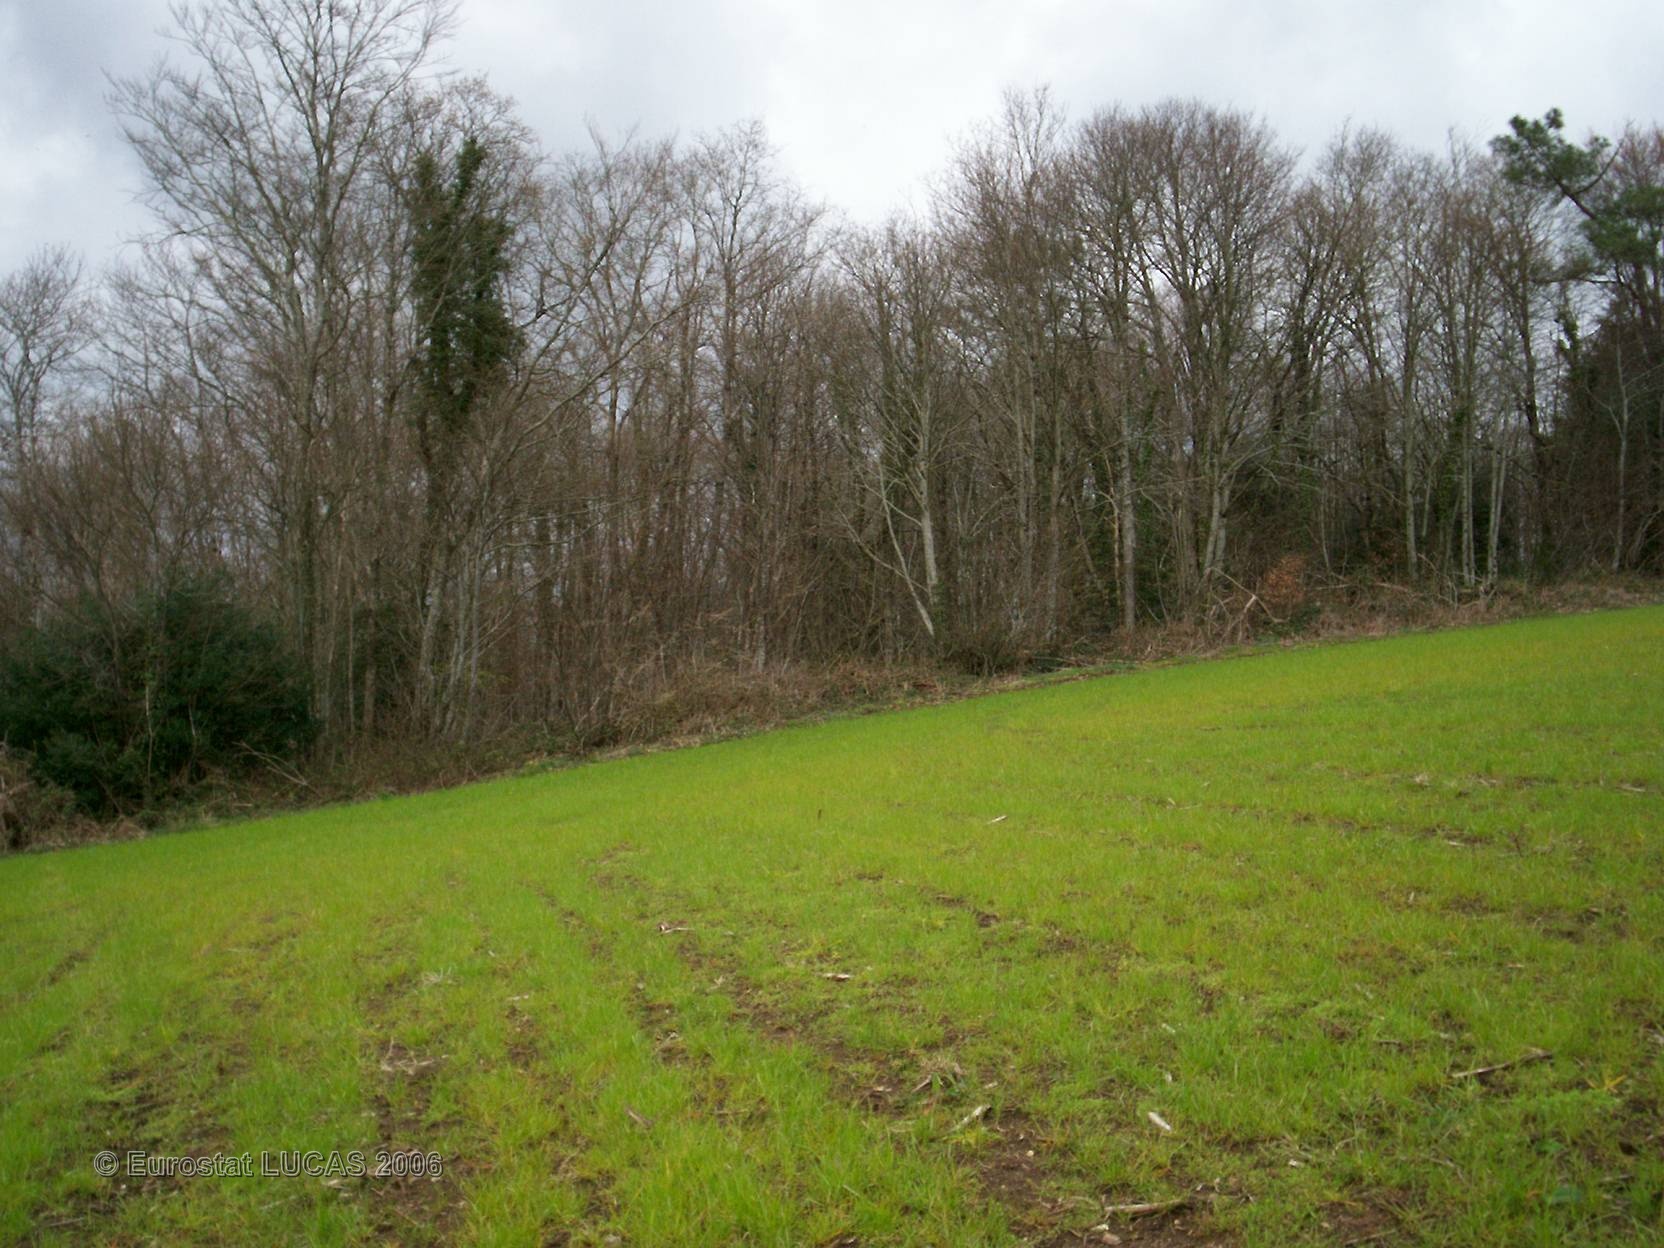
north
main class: Grassland
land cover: Grassland without tree/shrub cover
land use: Agriculture (excluding fallow land and kitchen gardens)
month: April
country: FR
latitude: 48.0027
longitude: -3.5478
